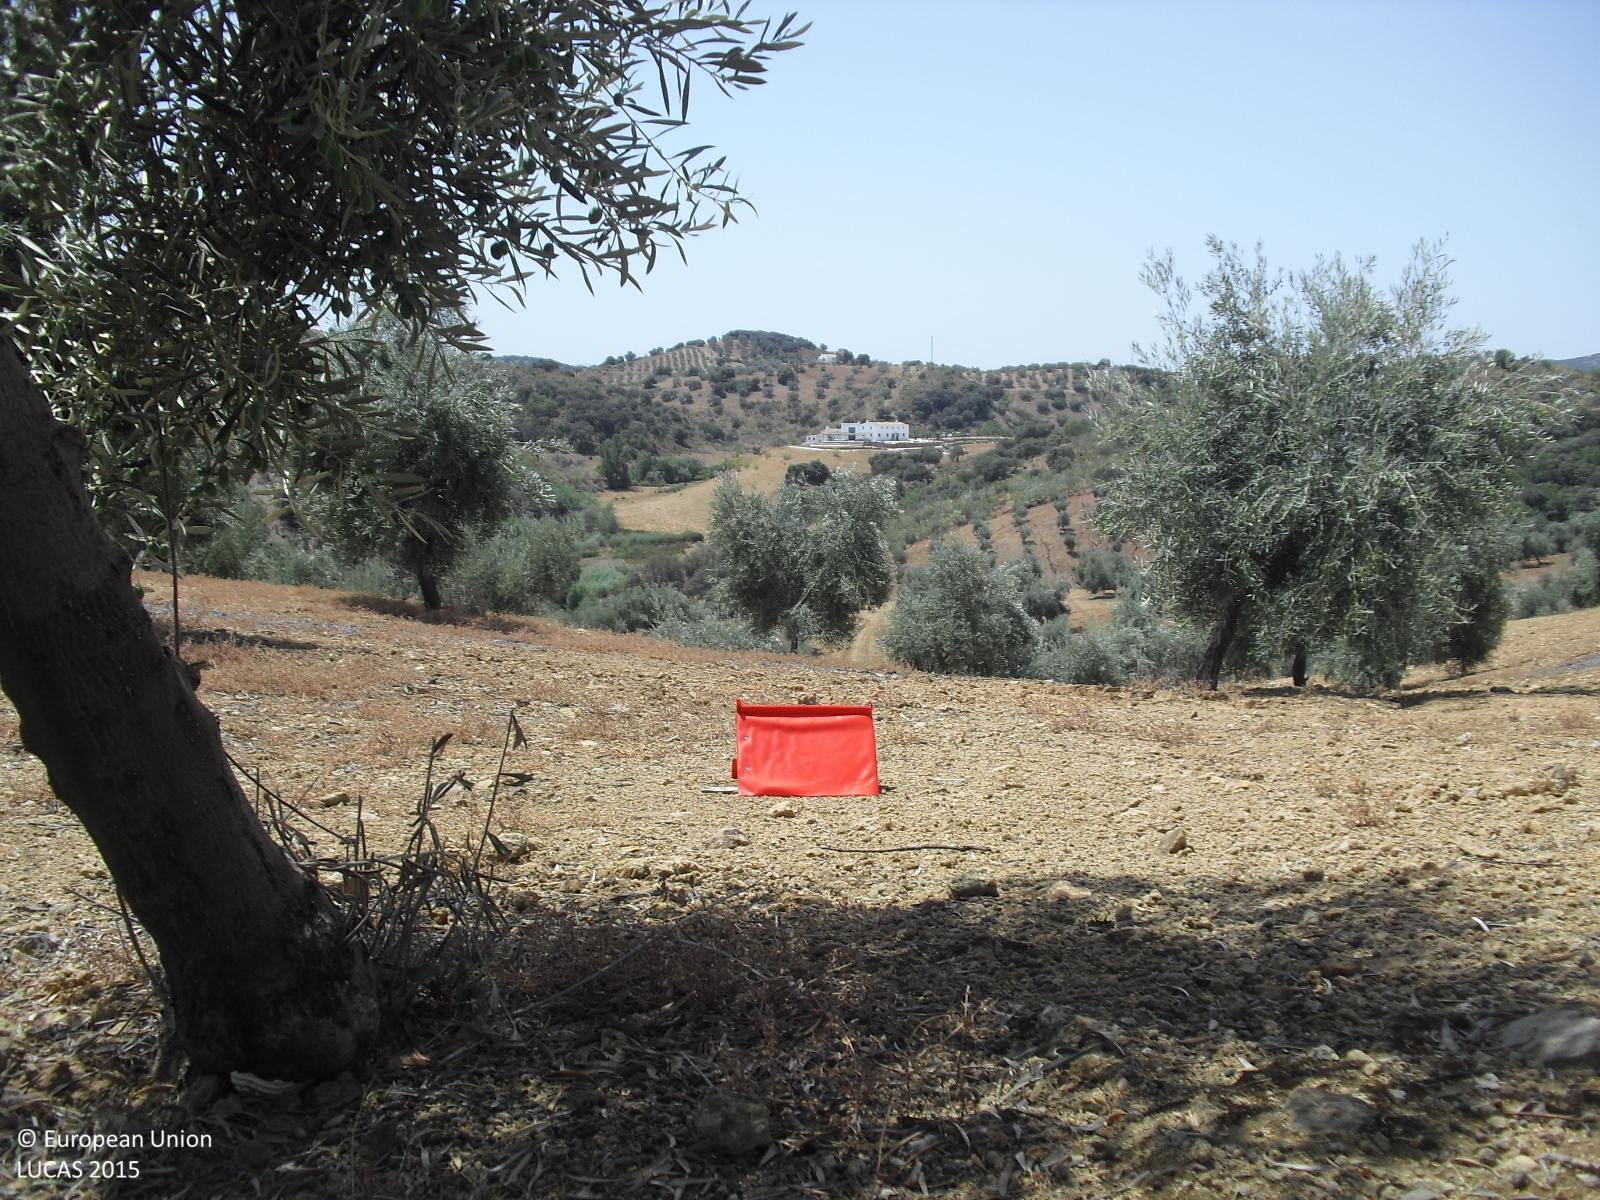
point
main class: Cropland
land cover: Olive groves
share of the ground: 10 - 25 %
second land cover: Other bare soil
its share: > 75 %
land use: Agriculture (excluding fallow land and kitchen gardens)
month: July
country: ES
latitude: 37.1738
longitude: -4.3114
